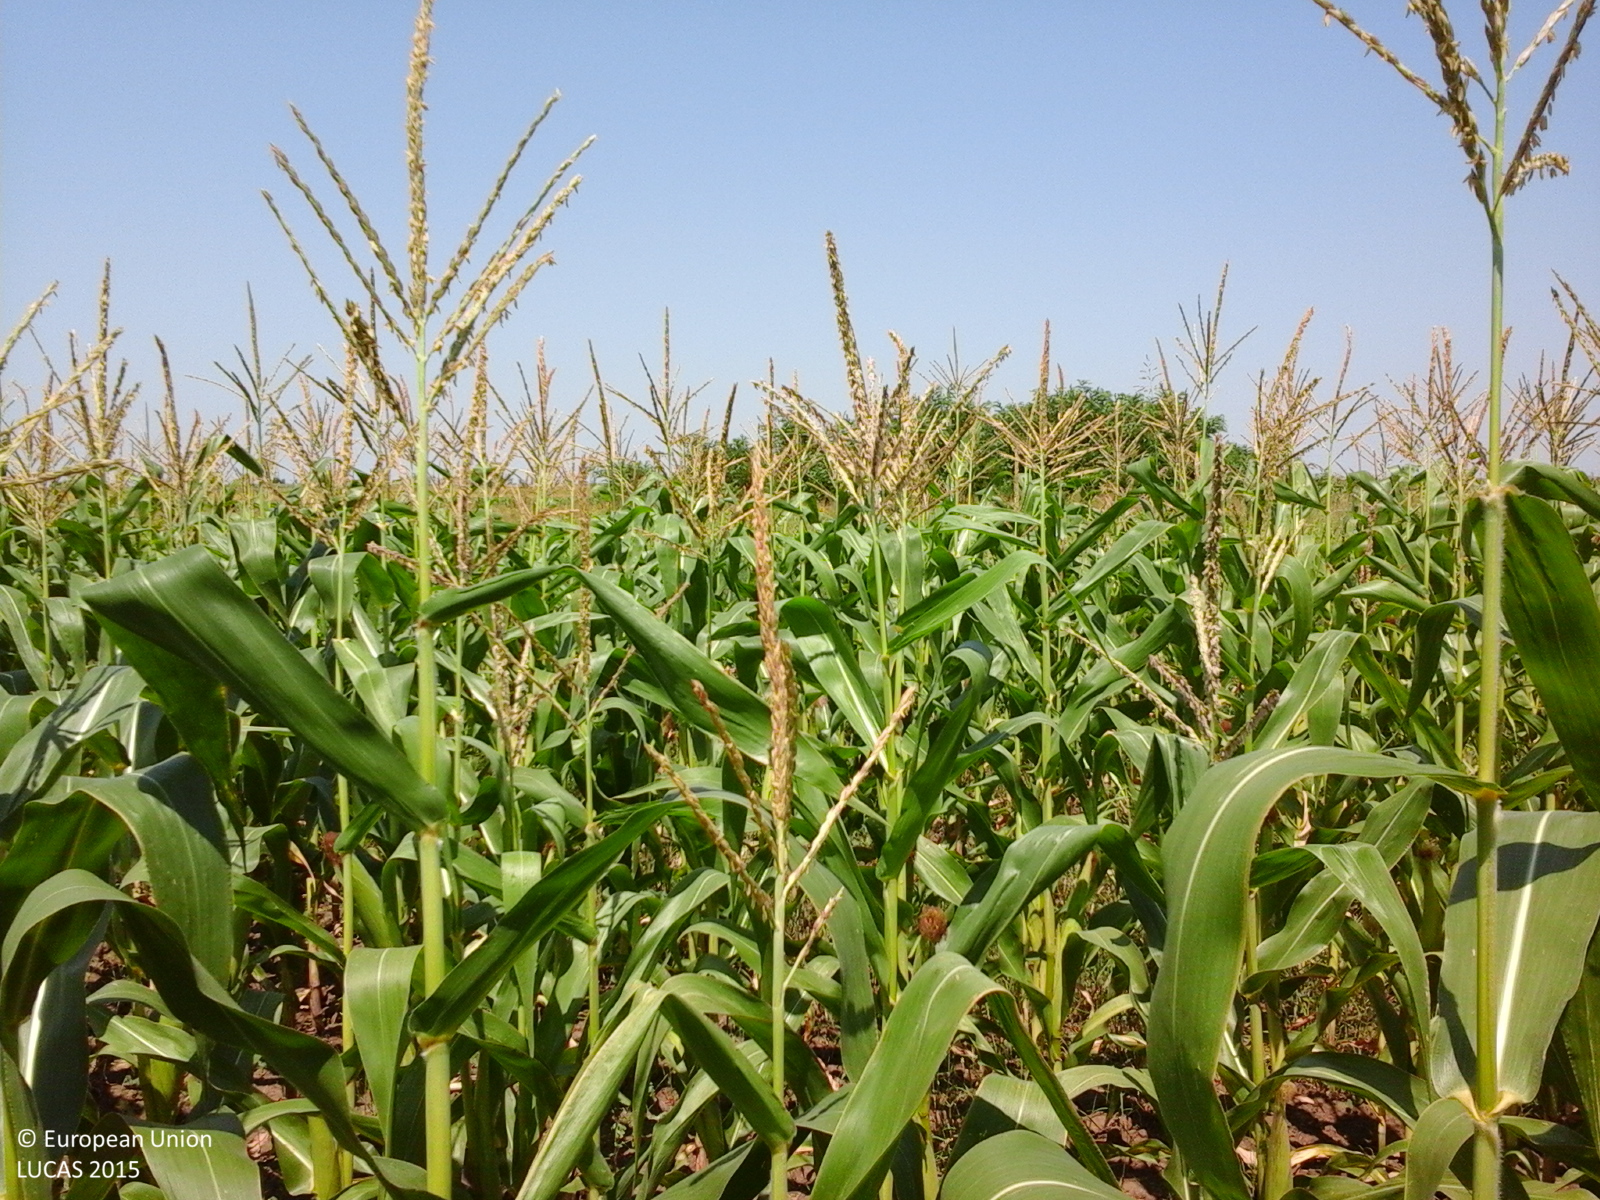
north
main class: Cropland
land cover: Maize
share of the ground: > 75 %
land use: Agriculture (excluding fallow land and kitchen gardens)
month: July
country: RO
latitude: 44.9261
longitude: 27.3094
